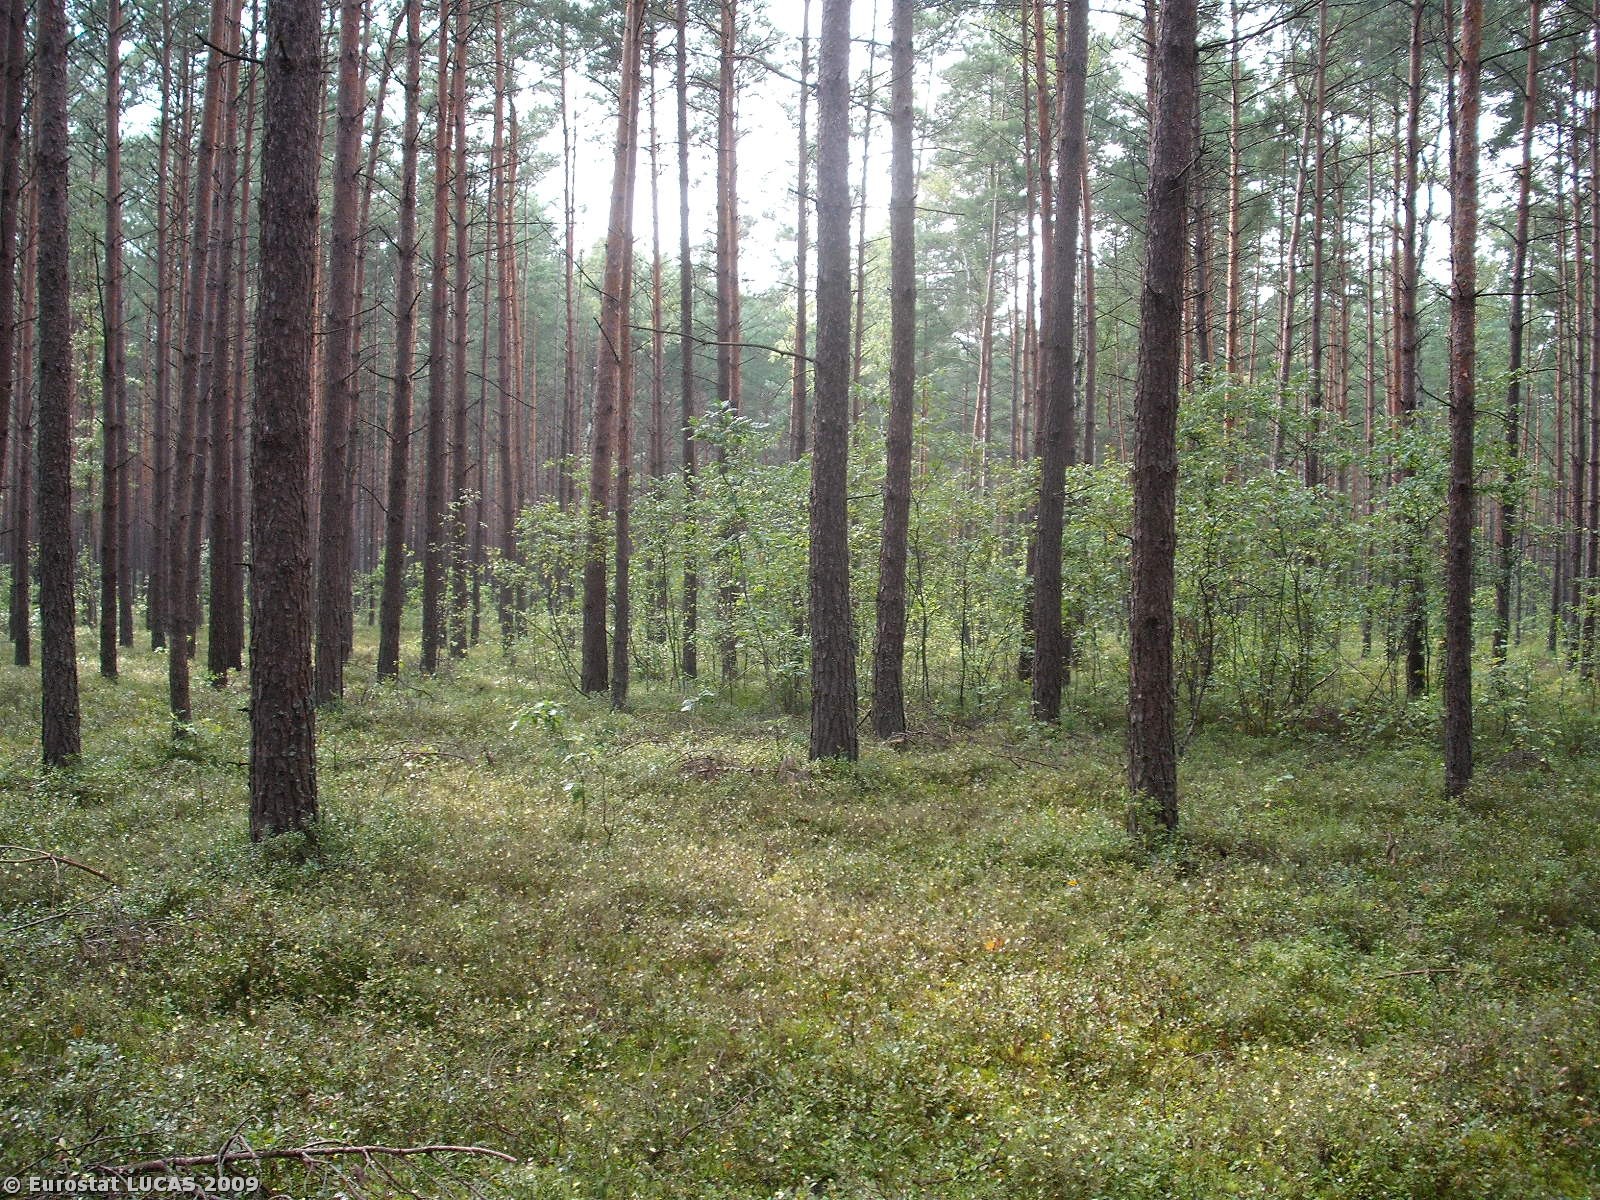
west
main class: Woodland
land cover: Coniferous woodland
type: hemiboreal forest and nemoral coniferous forest and mixed broadleaved-coniferous forest
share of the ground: > 75 %
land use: Forestry
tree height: > 5 m
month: August
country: PL
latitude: 52.3893
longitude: 21.5869
